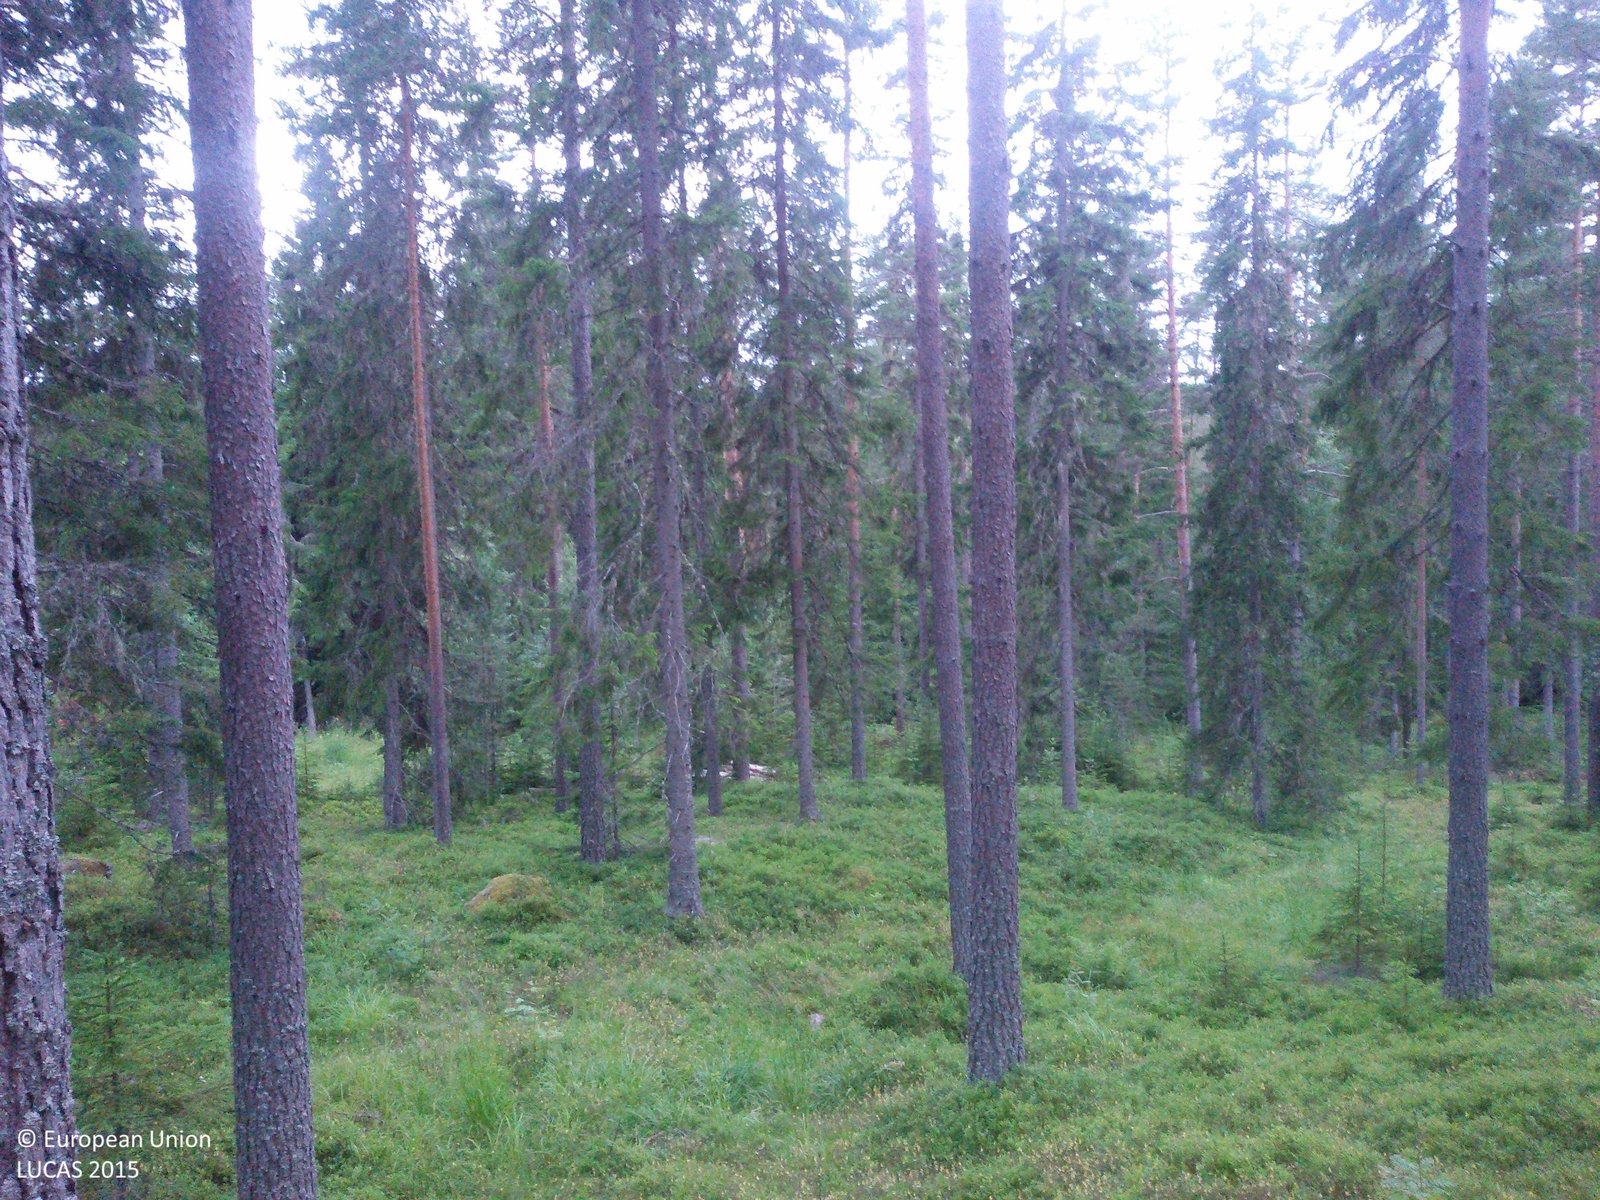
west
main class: Woodland
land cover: Pine dominated coniferous woodland
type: boreal forest
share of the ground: 50 - 75 %
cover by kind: coniferous forest trees 50 %, shrubs 25 %, lichens and mosses 20 %, herbaceous plants 5 %
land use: Forestry
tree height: > 5 m
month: July
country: SE
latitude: 60.4609
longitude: 15.2793
